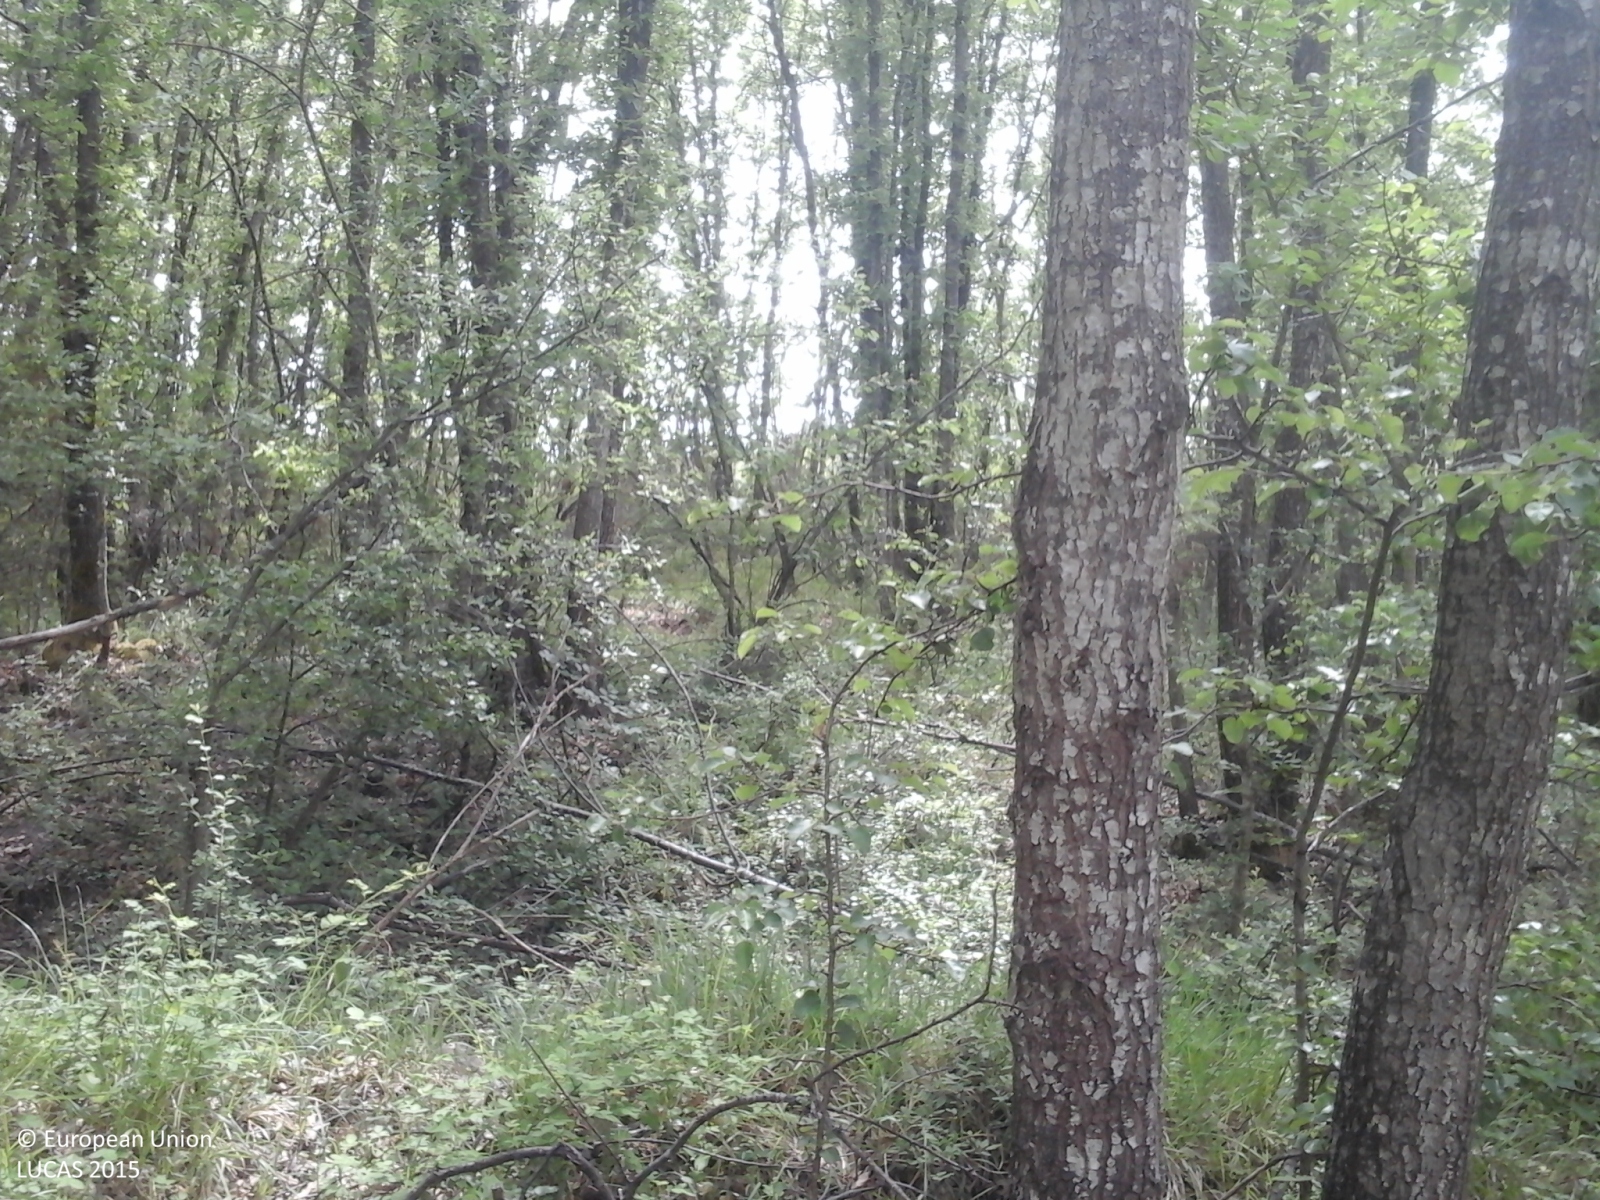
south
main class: Woodland
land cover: Broadleaved woodland
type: thermophilous deciduous forest
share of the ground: > 75 %
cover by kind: broadleaved forest trees 90 %, shrubs 5 %, herbaceous plants 5 %
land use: Forestry
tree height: > 5 m
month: May
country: IT
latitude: 44.2388
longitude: 10.8619
